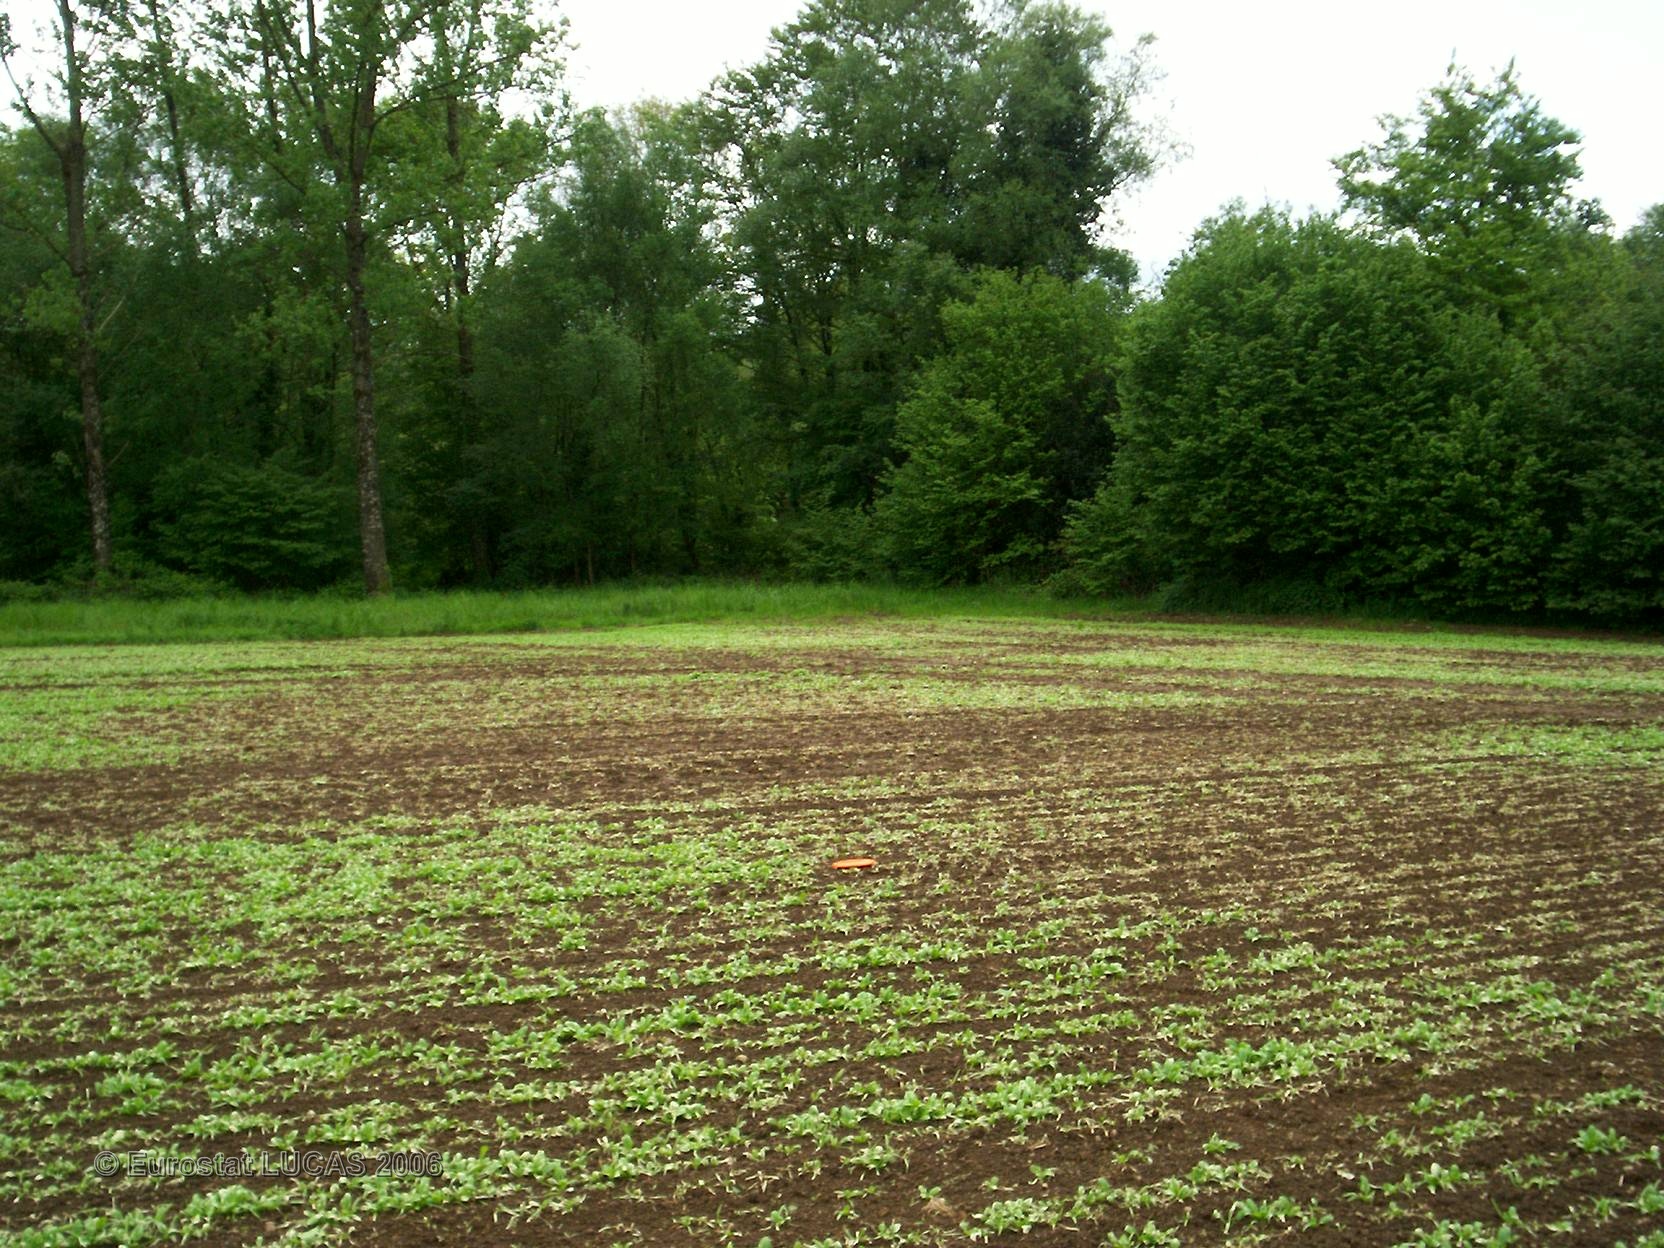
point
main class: Cropland
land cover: Other fresh vegetables
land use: Agriculture (excluding fallow land and kitchen gardens)
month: May
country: FR
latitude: 48.1472
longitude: -3.5596
